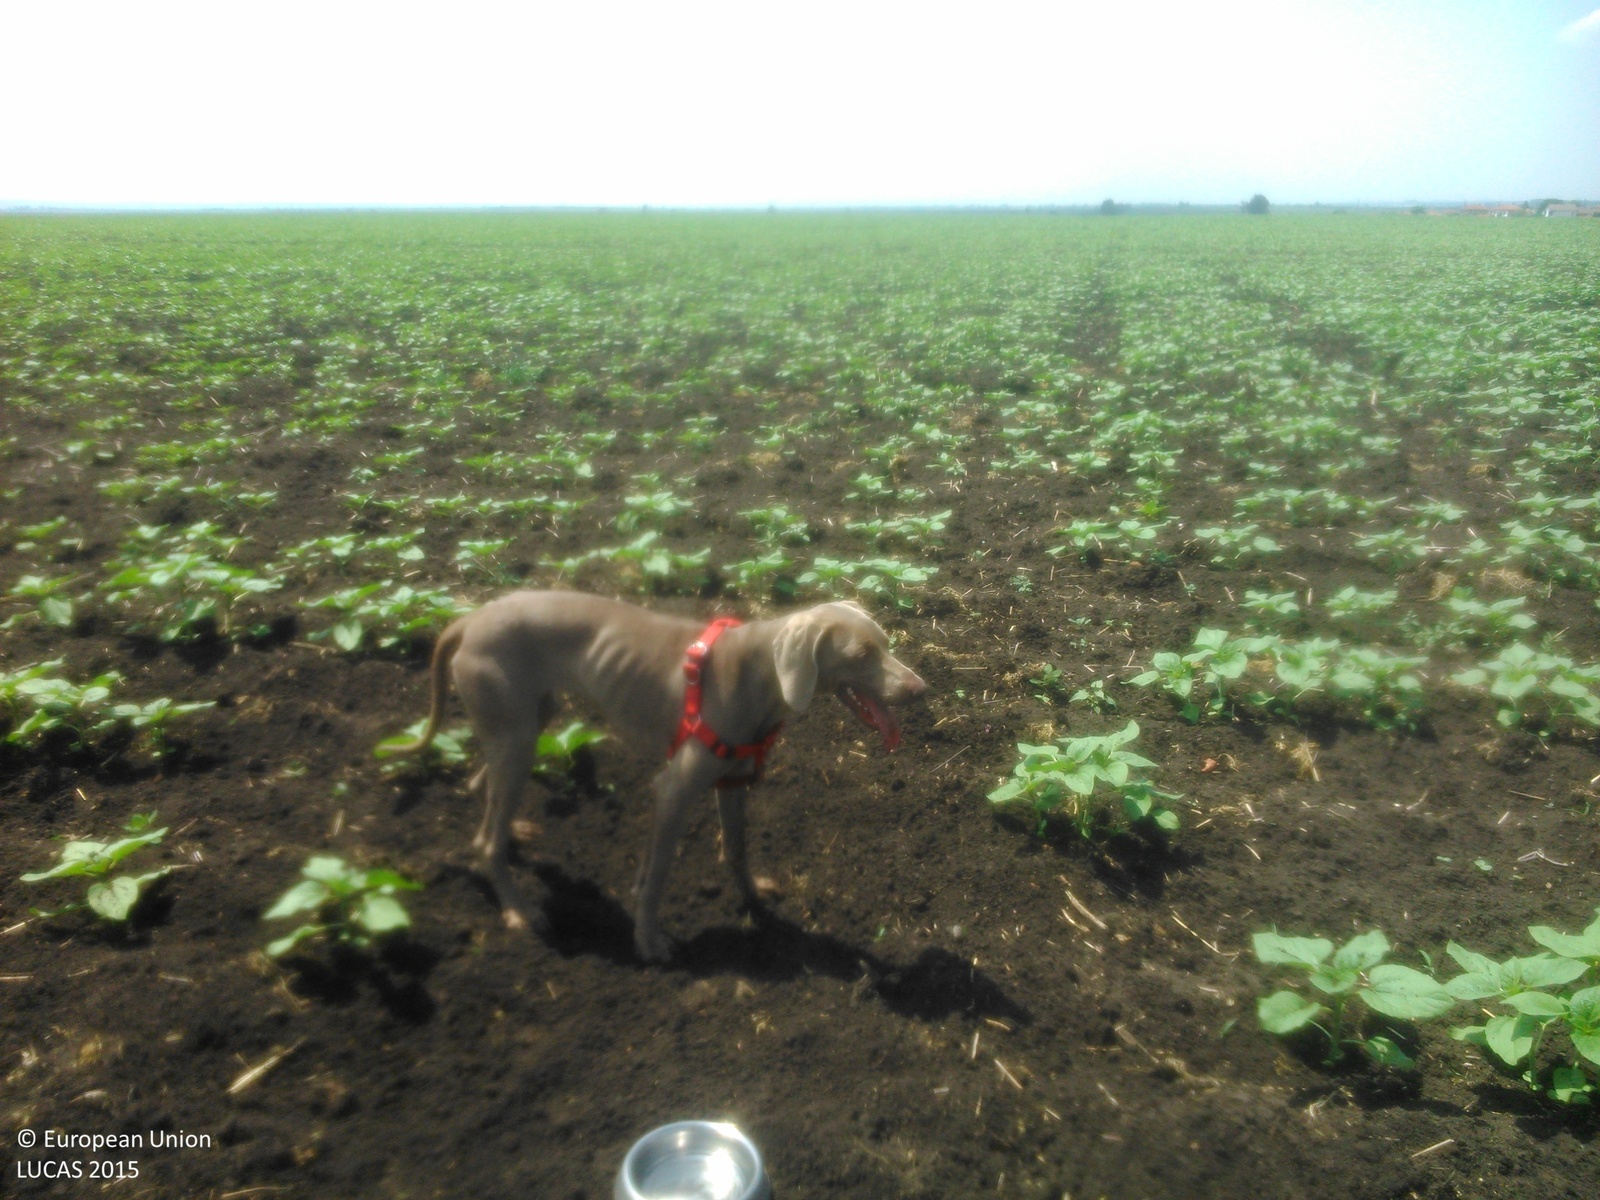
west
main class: Cropland
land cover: Sunflower
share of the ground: 10 - 25 %
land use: Agriculture (excluding fallow land and kitchen gardens)
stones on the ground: < 10 %
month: May
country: BG
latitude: 42.2087
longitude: 25.2383
